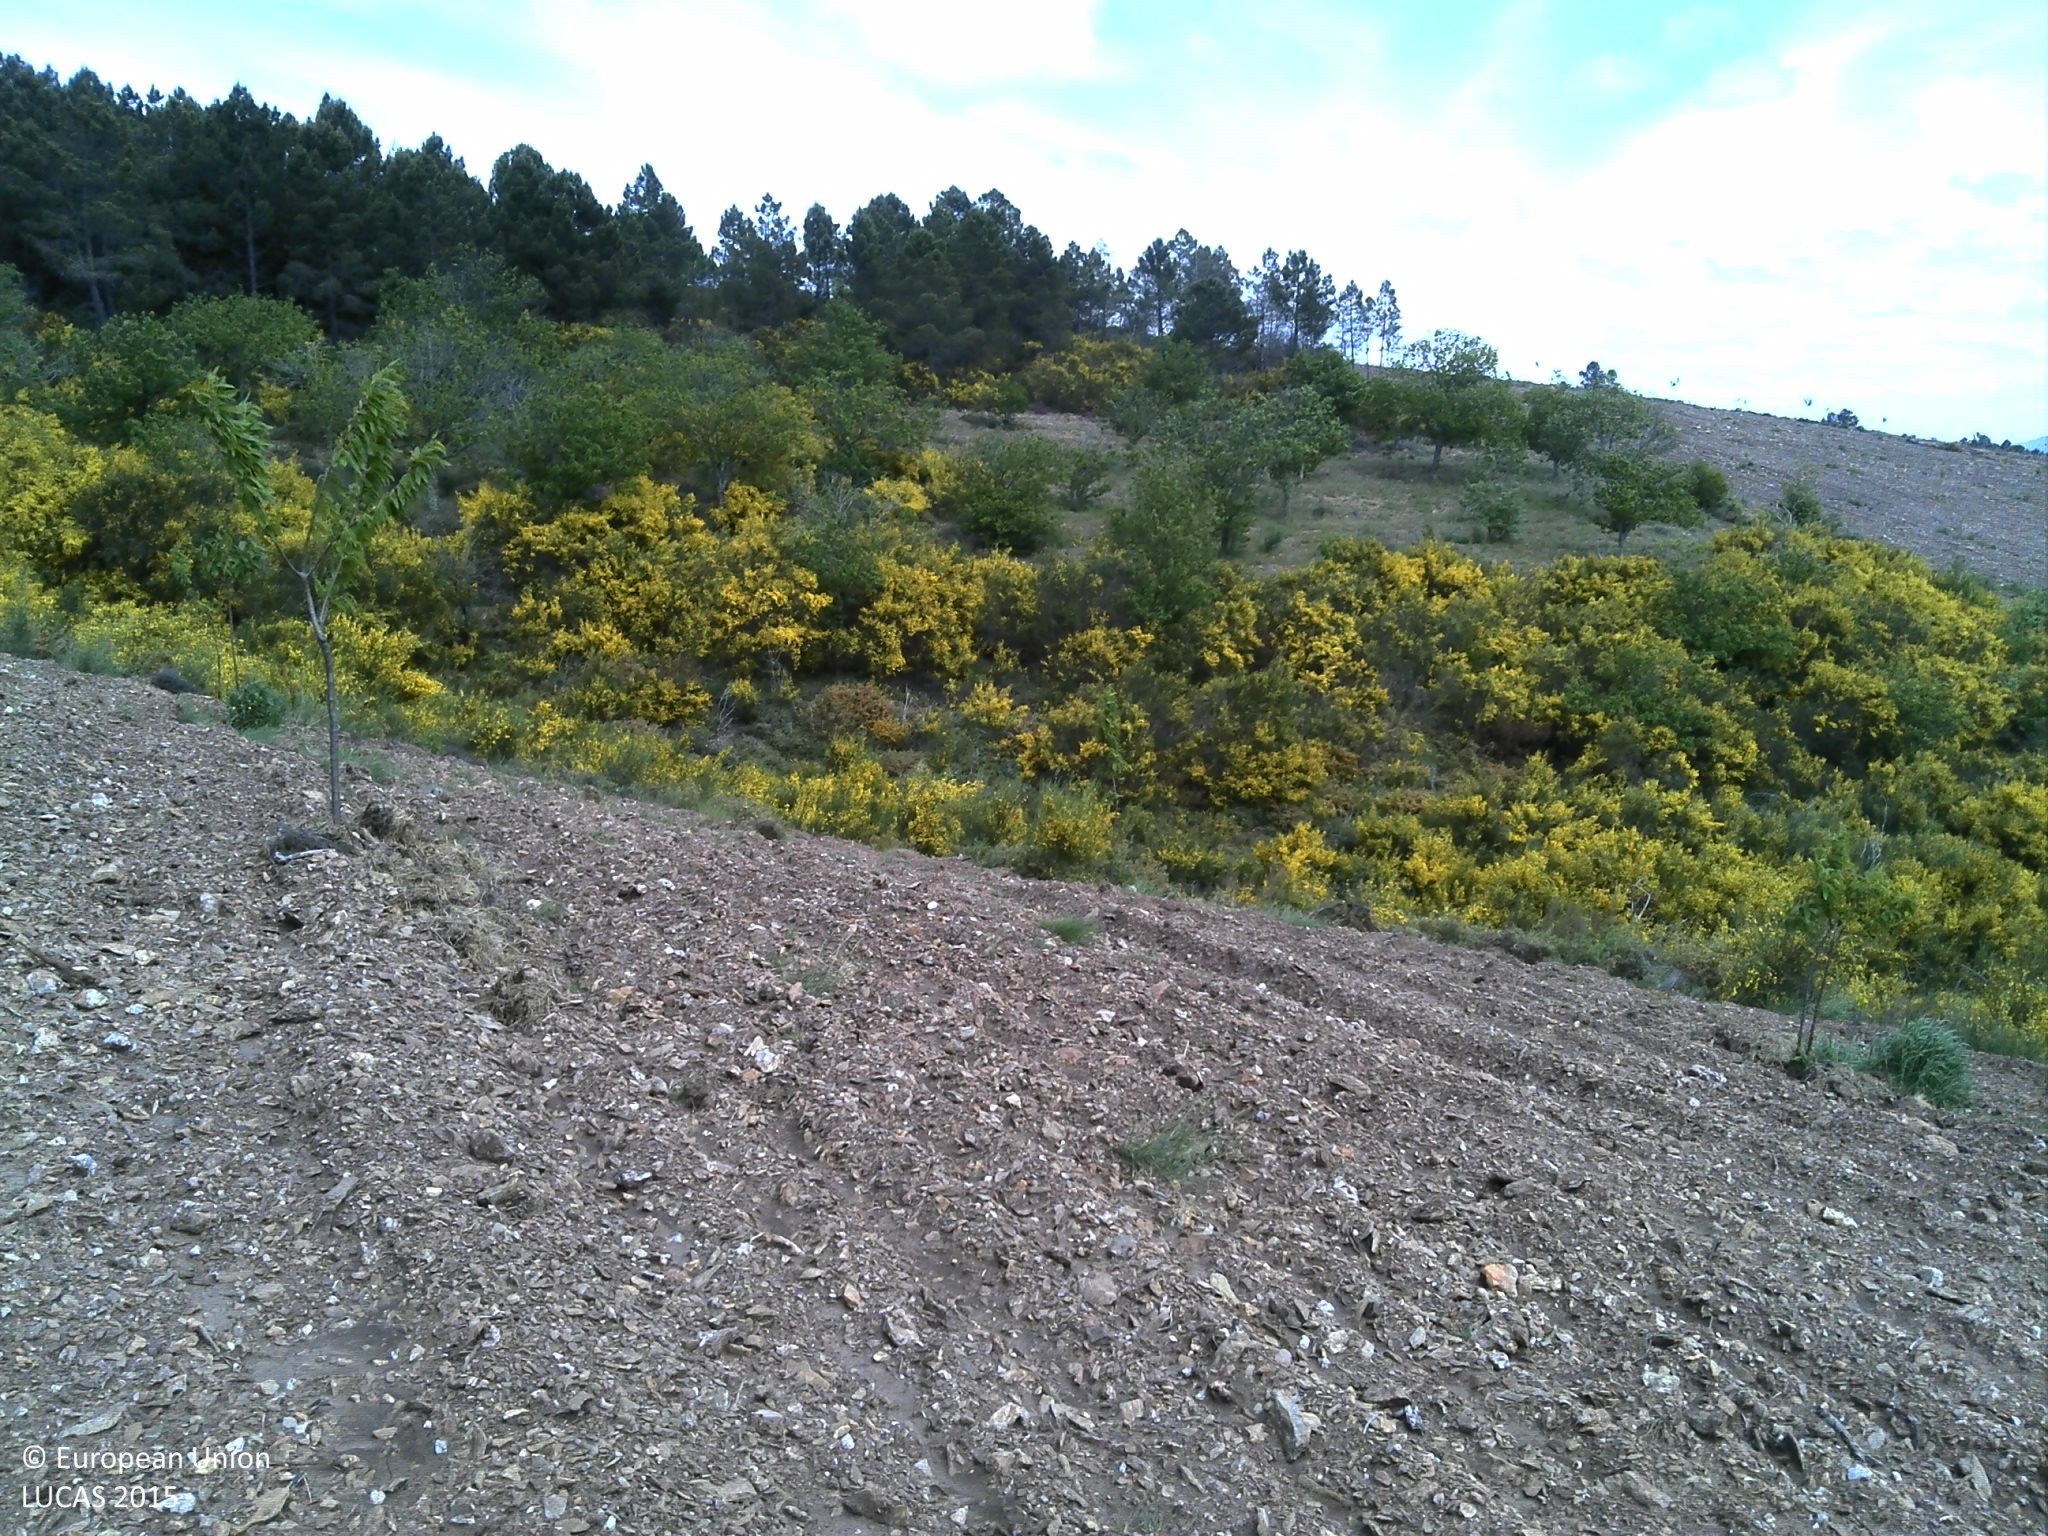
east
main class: Cropland
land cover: Nuts trees
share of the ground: < 10 %
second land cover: Other bare soil
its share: > 75 %
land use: Agriculture (excluding fallow land and kitchen gardens)
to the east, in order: Nuts trees; Other bare soil; Shrubland without tree cover; Shrubland with sparse tree cover; Nuts trees; Shrubland with sparse tree cover; Tracks; Nuts trees
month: May
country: PT
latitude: 41.5410
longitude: -7.4970
